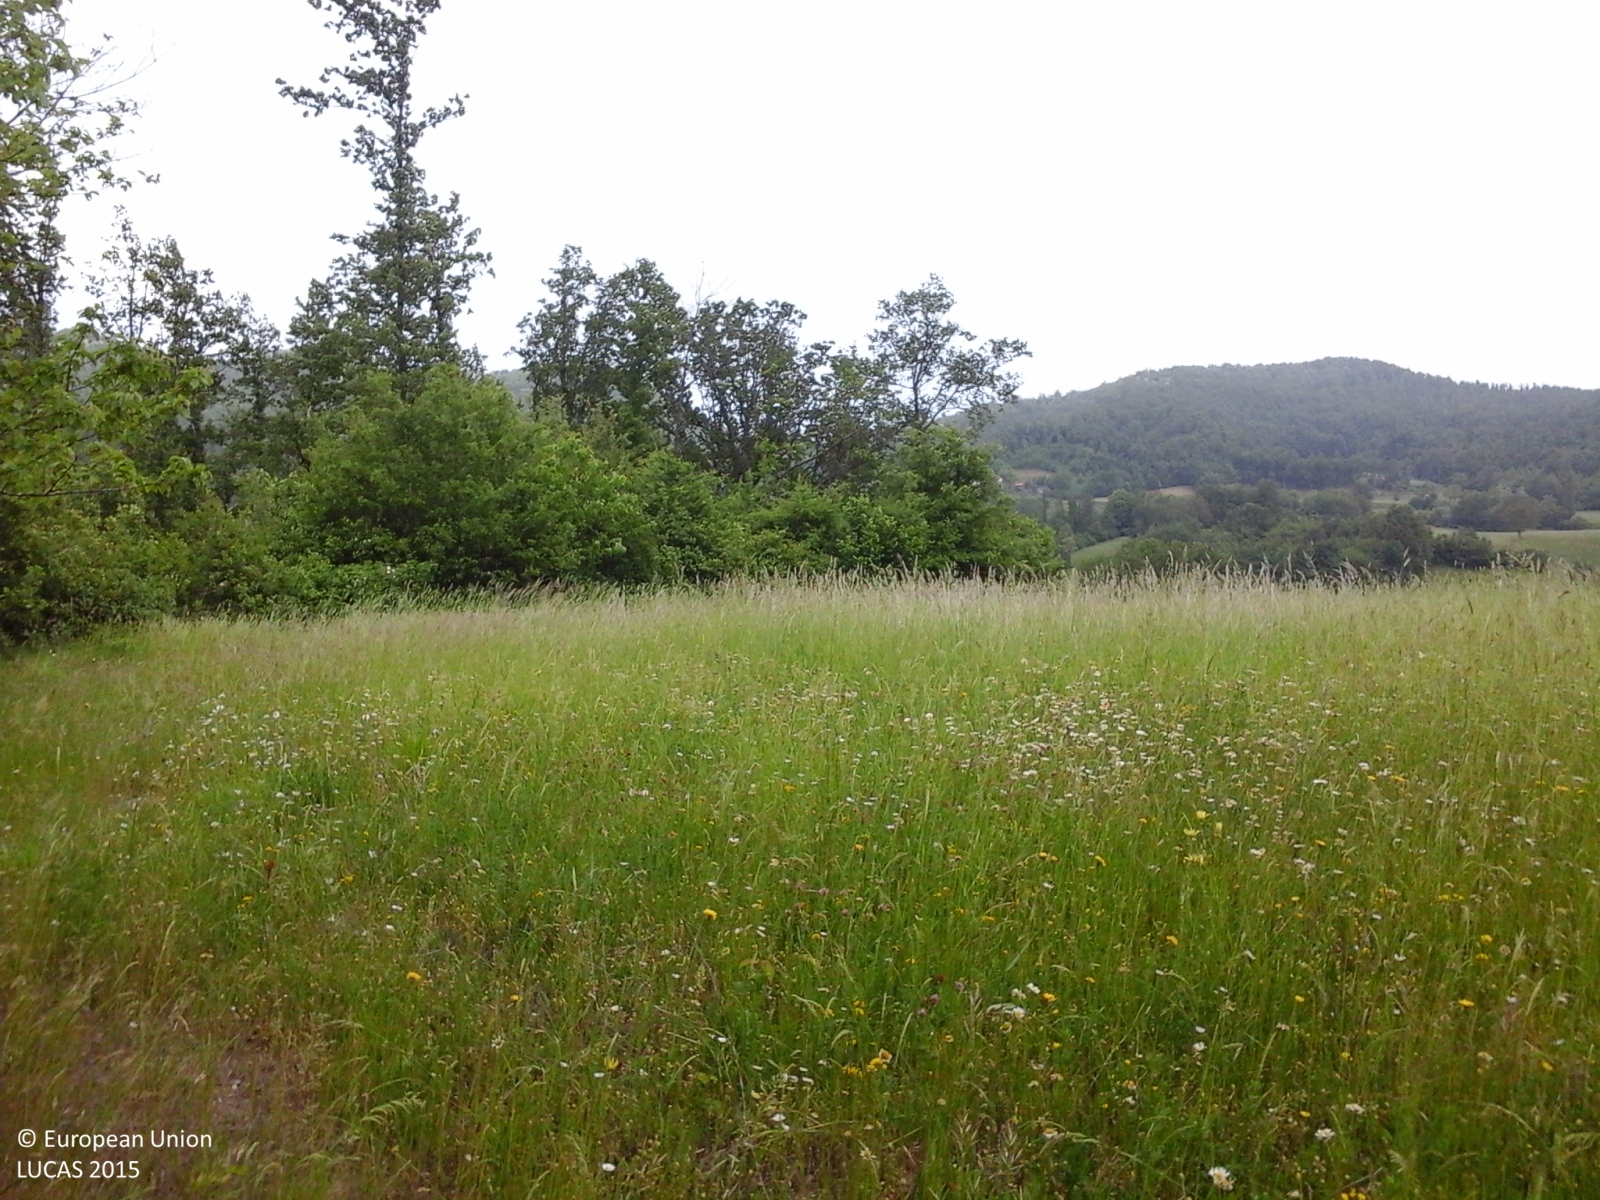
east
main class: Woodland
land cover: Broadleaved woodland
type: thermophilous deciduous forest
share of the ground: > 75 %
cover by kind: broadleaved forest trees 70 %, shrubs 30 %
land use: Forestry
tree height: > 5 m
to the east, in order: Broadleaved woodland; Rivers and streams; Broadleaved woodland
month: May
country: IT
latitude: 44.6571
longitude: 9.9119
